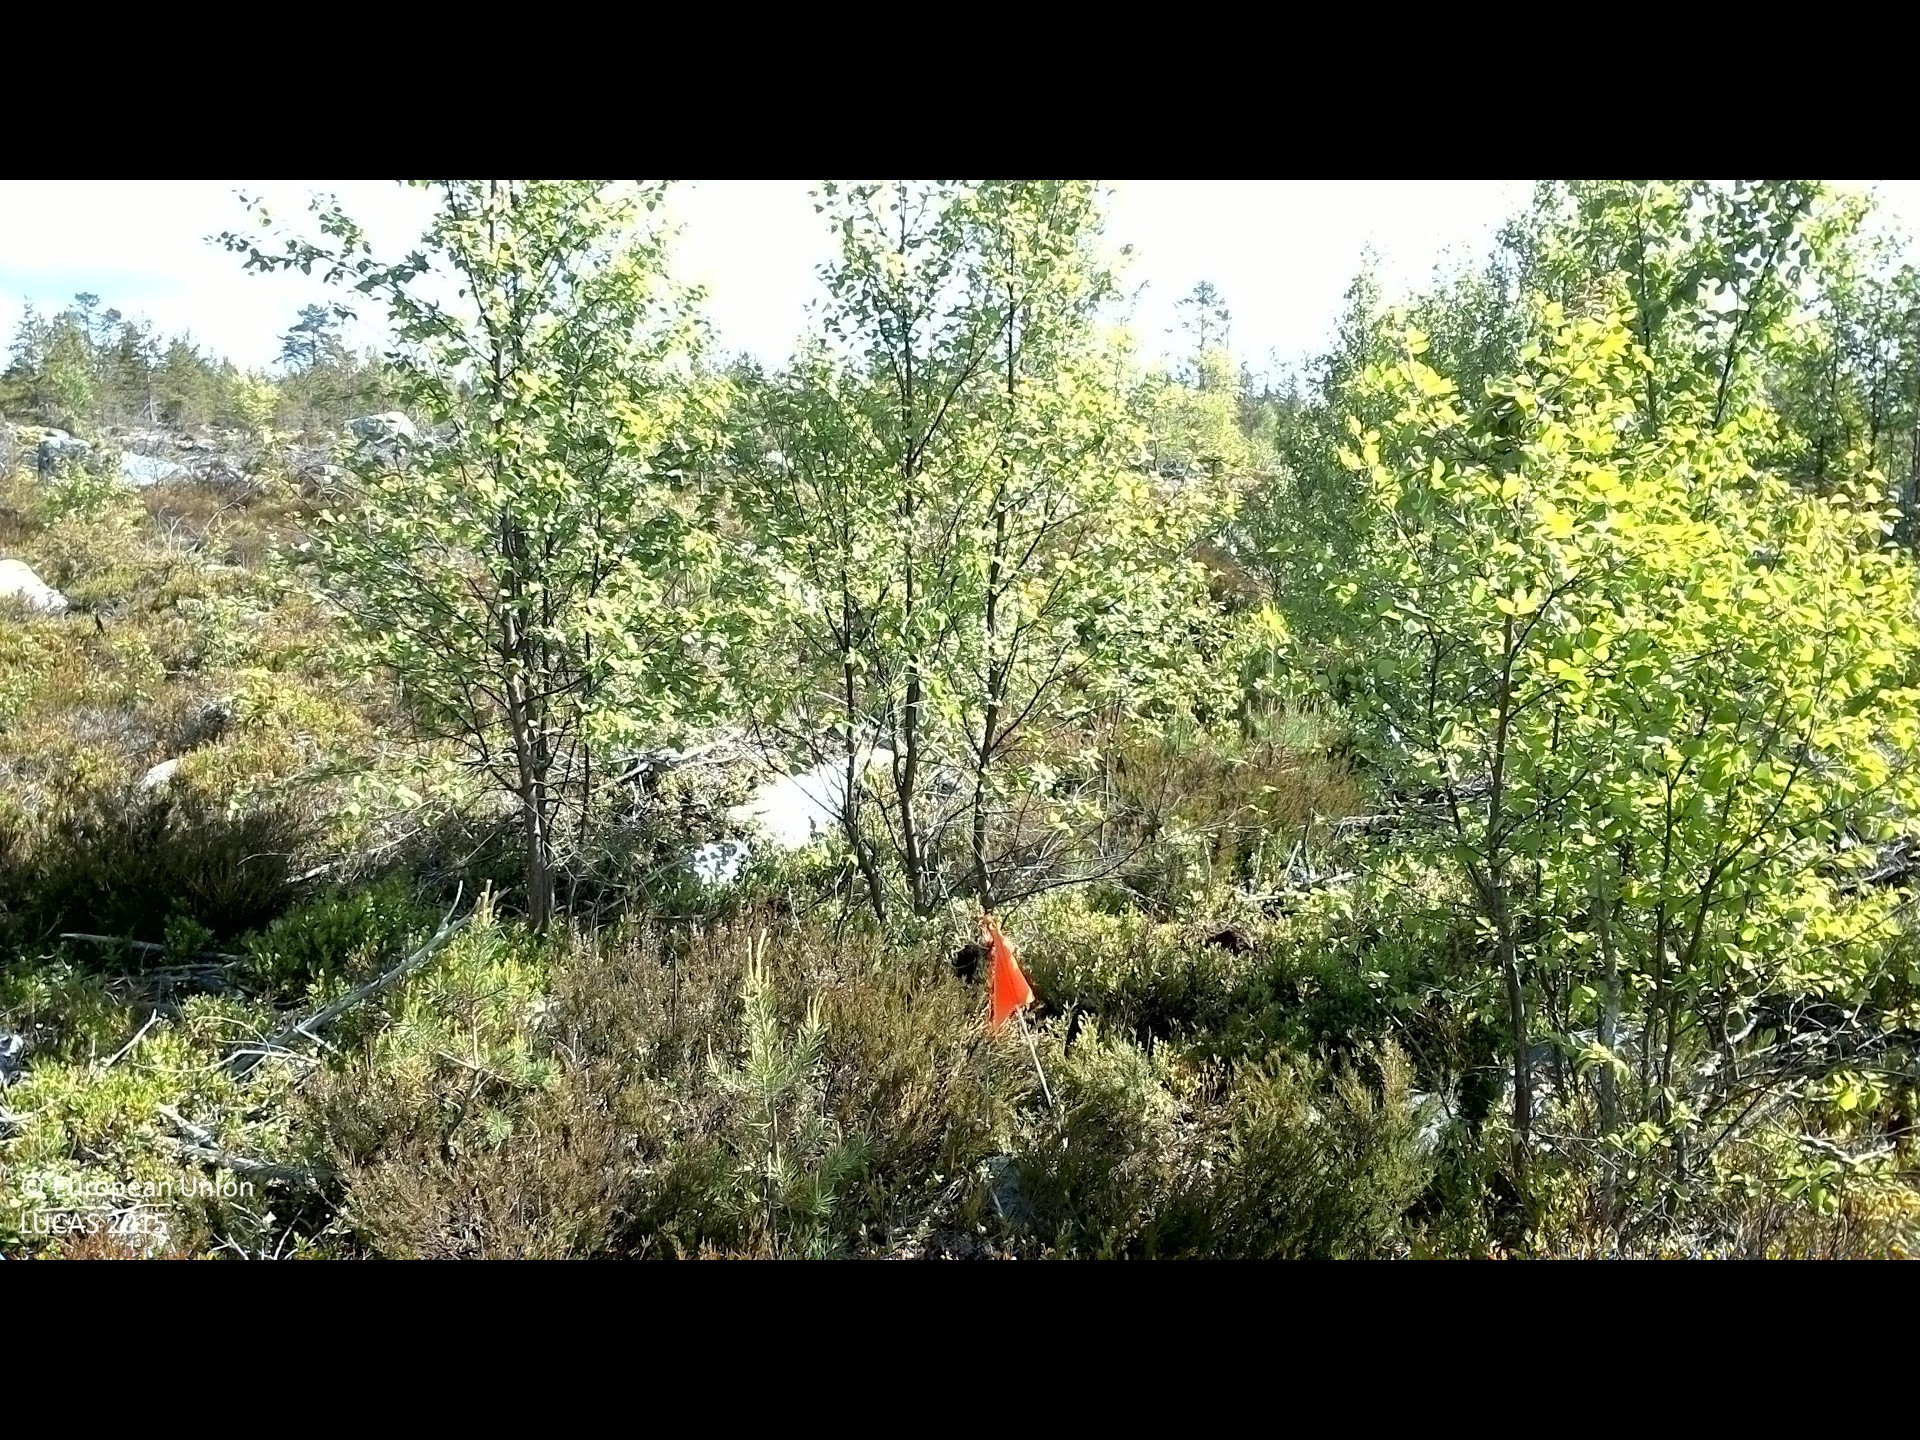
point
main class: Woodland
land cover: Broadleaved woodland
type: boreal forest
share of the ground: 10 - 25 %
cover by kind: shrubs 60 %, broadleaved forest trees 20 %, lichens and mosses 15 %, coniferous forest trees 5 %
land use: Forestry
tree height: > 5 m
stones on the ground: < 10 %
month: June
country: SE
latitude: 62.0488
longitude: 17.4220
